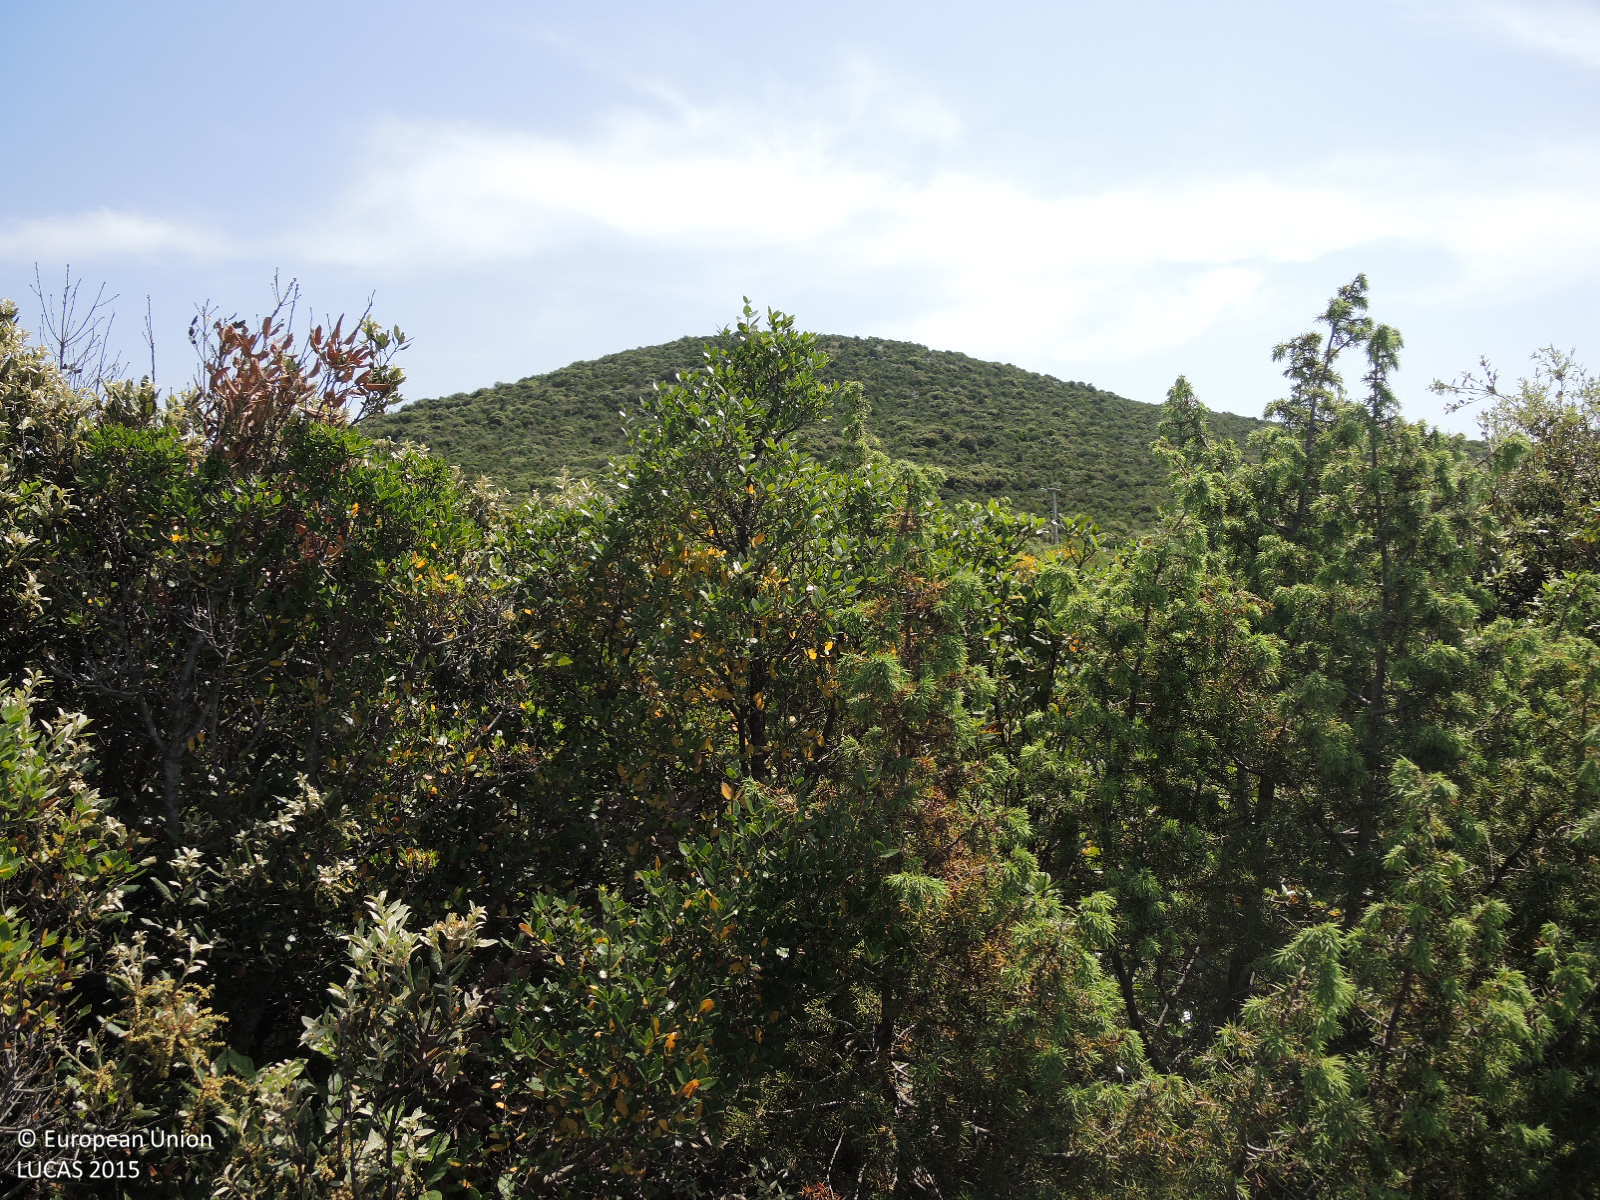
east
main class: Shrubland
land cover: Shrubland without tree cover
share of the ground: > 75 %
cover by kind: shrubs 70 %, herbaceous plants 20 %, unconsolidated bare surface 10 %
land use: Semi-natural and natural areas not in use
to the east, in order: Shrubland without tree cover; Tracks; Shrubland without tree cover; Dry stone walls; Shrubland without tree cover; Electric lines; Shrubland without tree cover
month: May
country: HR
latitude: 43.8503
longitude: 15.7011
